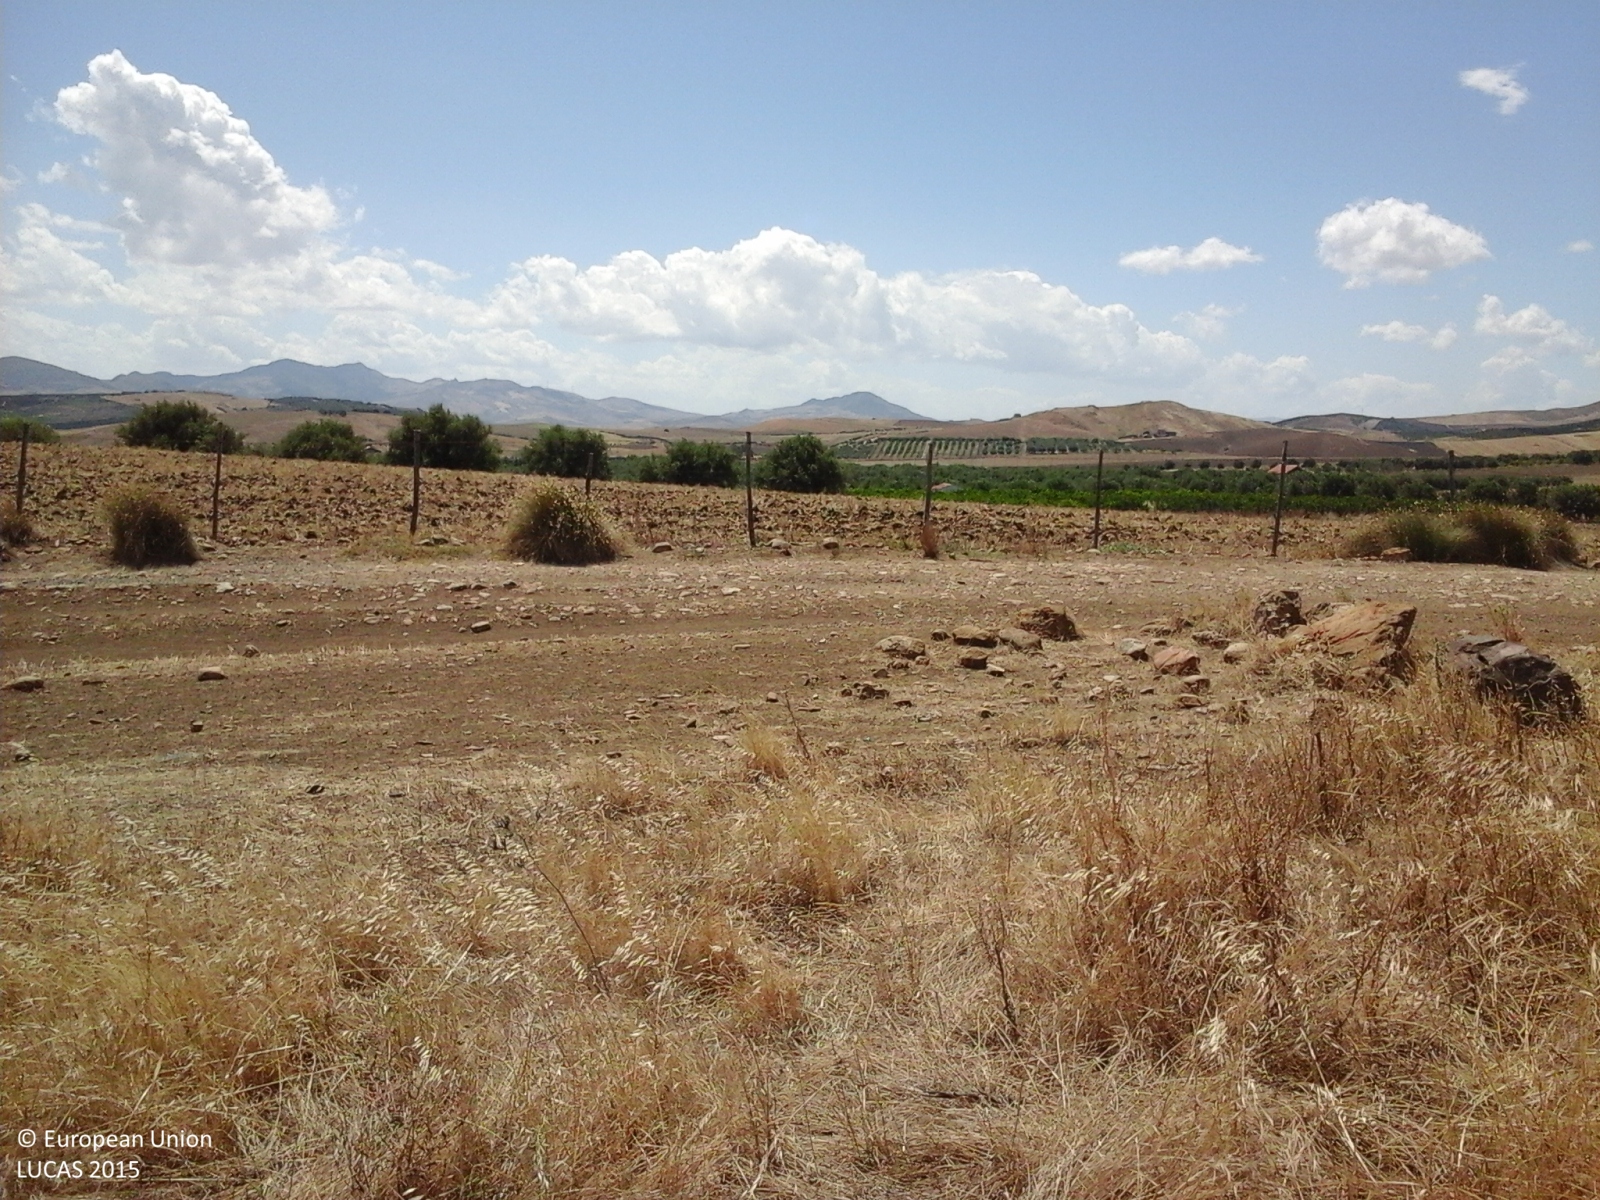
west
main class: Cropland
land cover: Mixed cereals for fodder
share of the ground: > 75 %
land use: Agriculture (excluding fallow land and kitchen gardens)
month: June
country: IT
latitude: 37.5344
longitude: 14.8201
